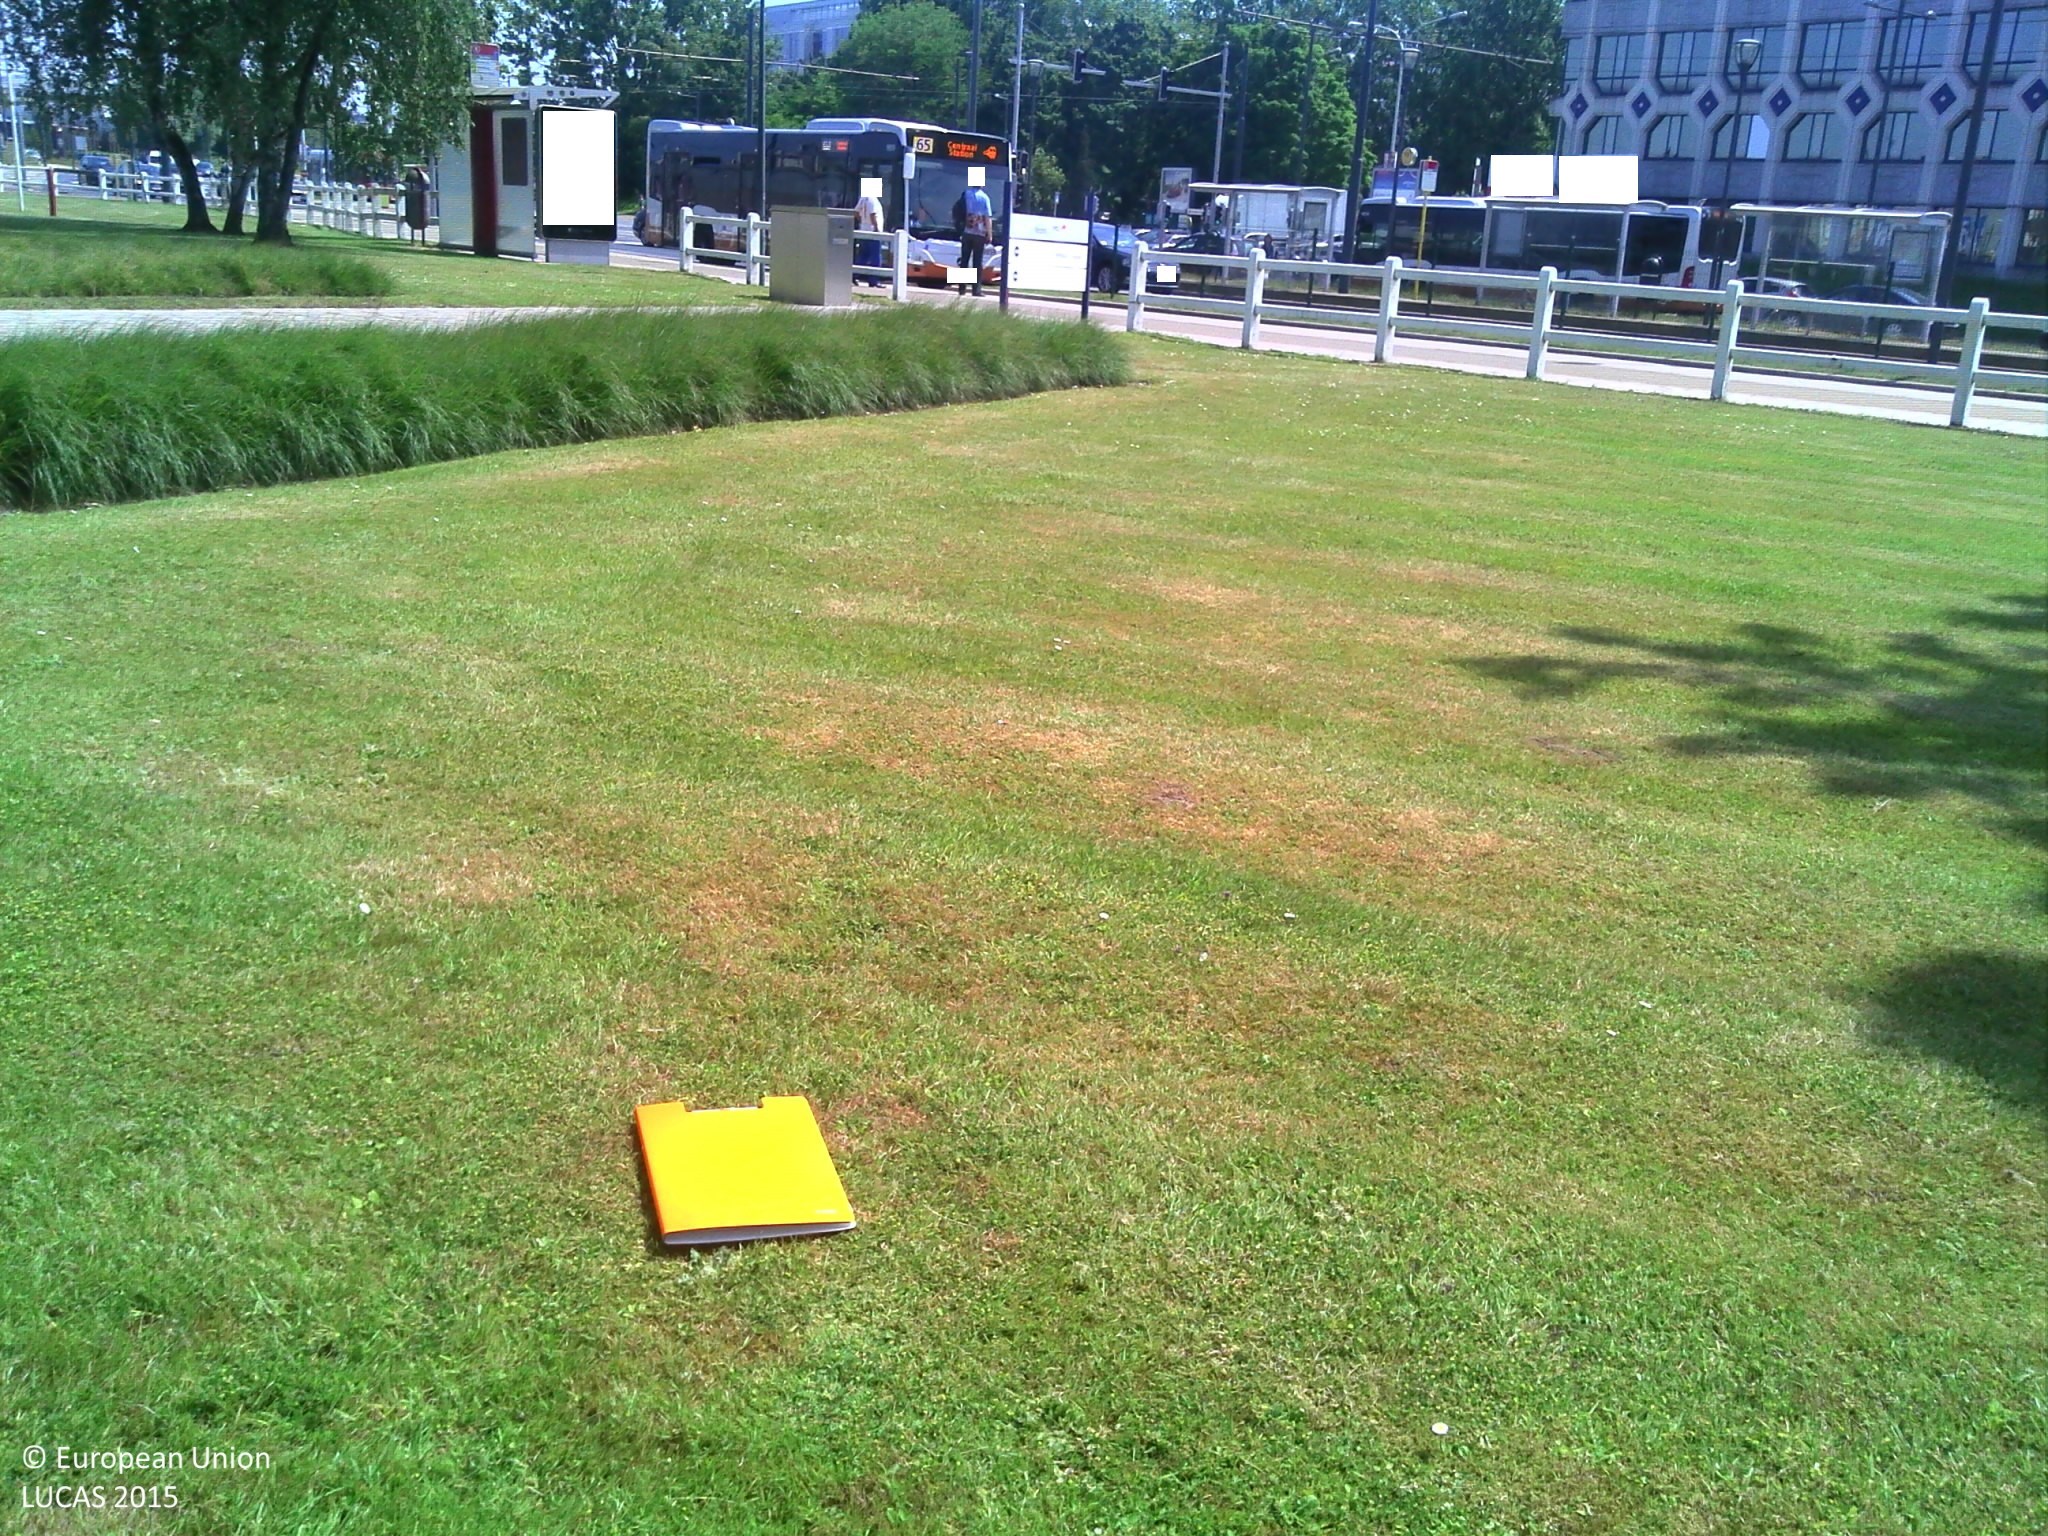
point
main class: Grassland
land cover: Grassland with sparse tree/shrub cover
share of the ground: > 75 %
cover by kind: herbaceous plants 90 %, broadleaved forest trees 5 %, shrubs 5 %
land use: Commerce
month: June
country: BE
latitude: 50.8763
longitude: 4.4102
